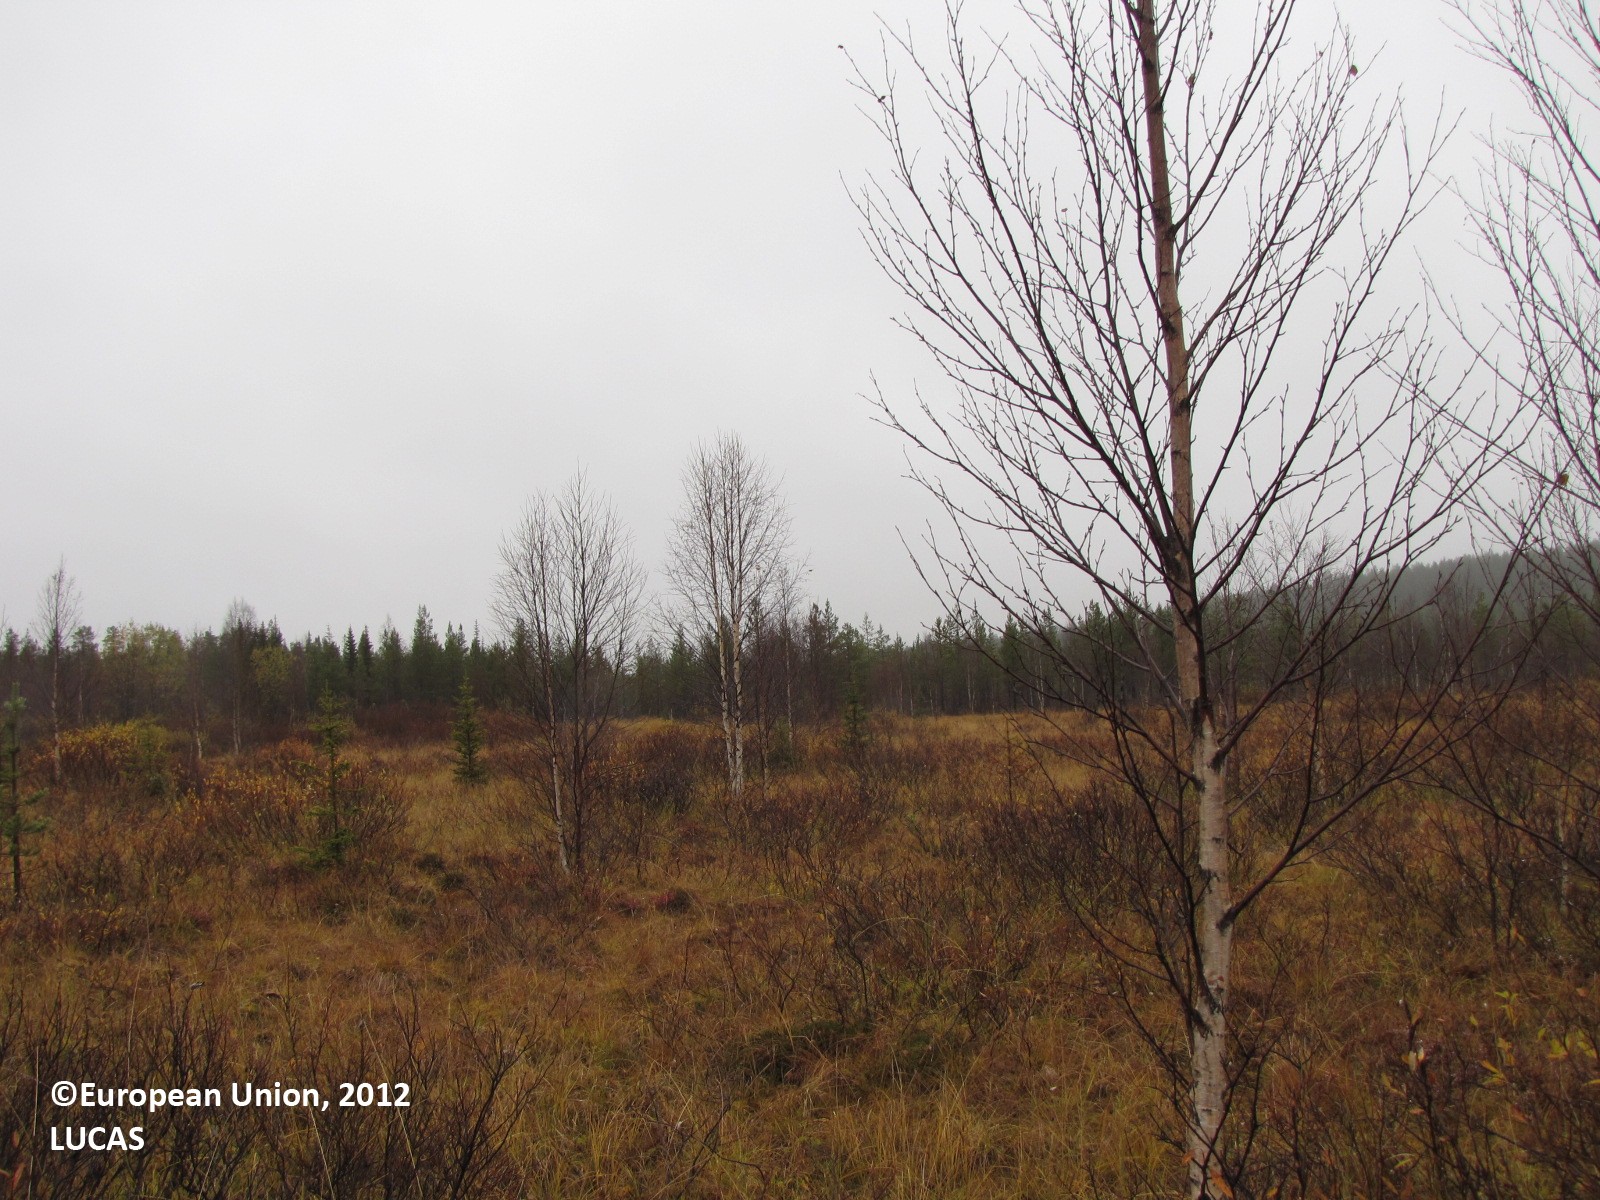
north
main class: Shrubland
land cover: Shrubland with sparse tree cover
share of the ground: 10 - 25 %
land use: Semi-natural and natural areas not in use
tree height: < 5 m
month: September
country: FI
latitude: 67.7501
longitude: 23.6220
